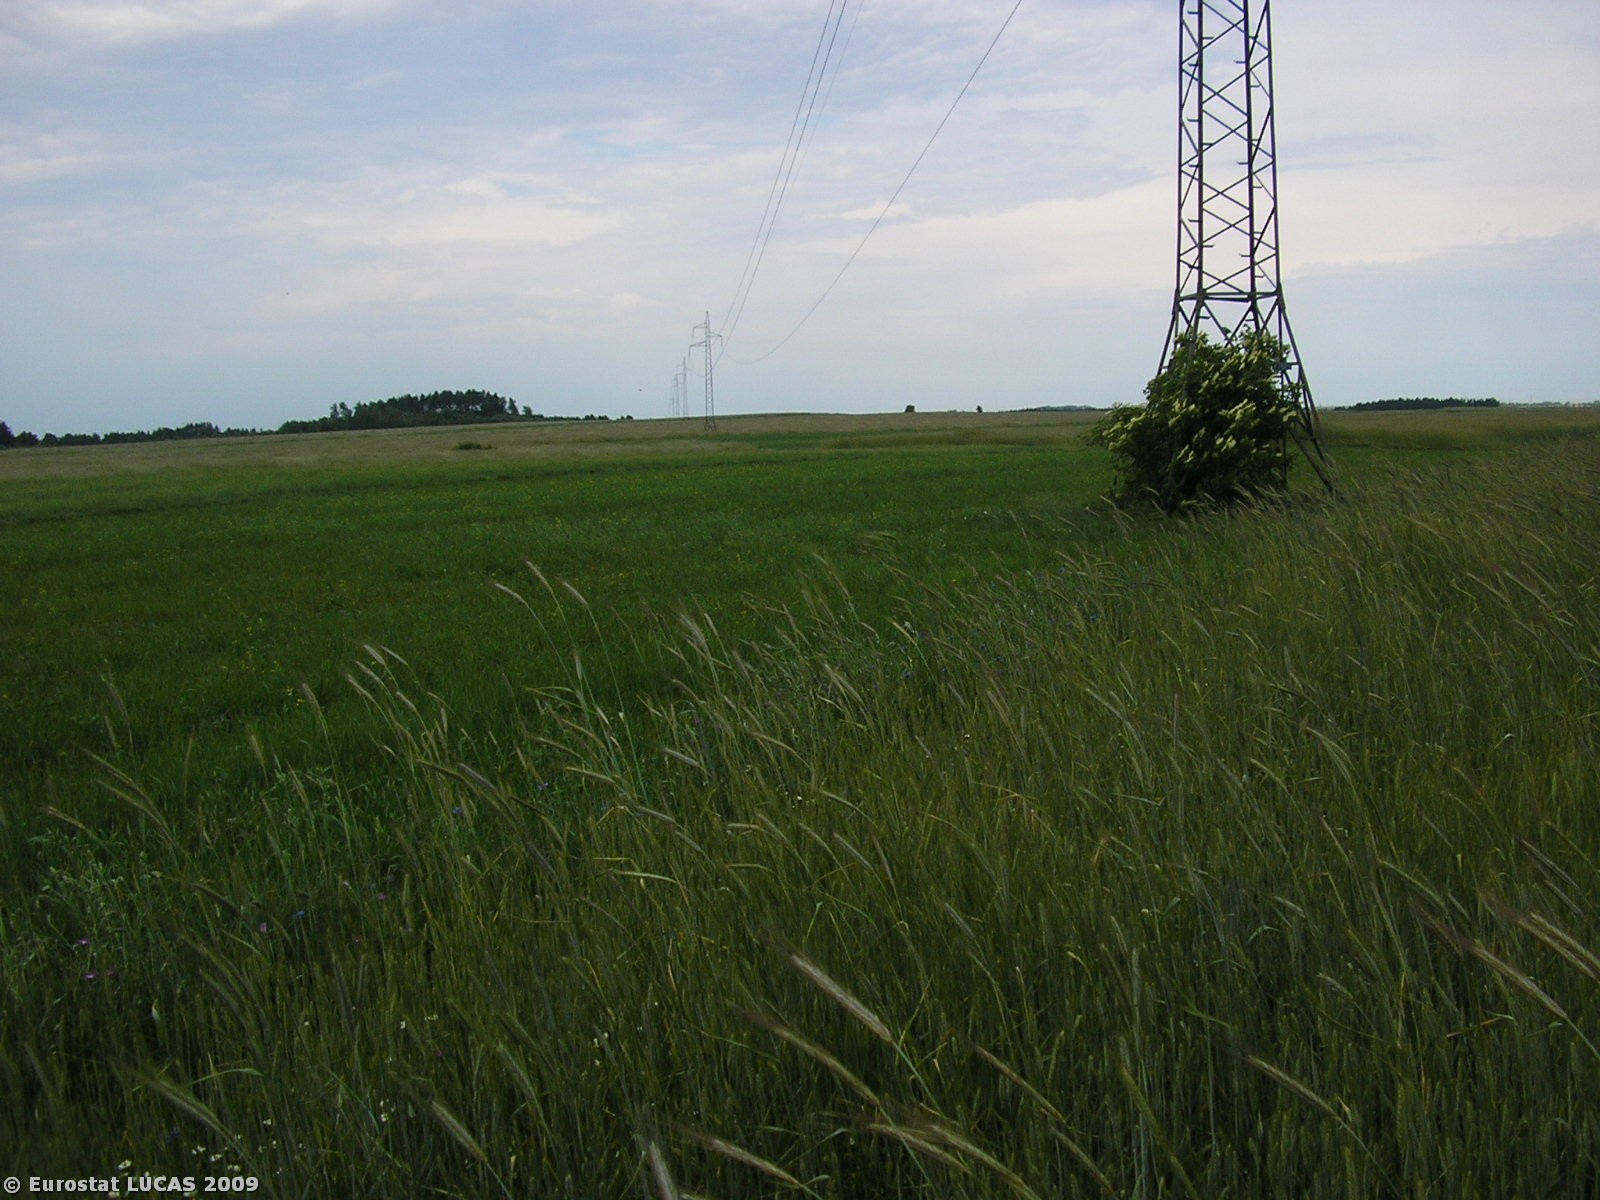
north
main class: Cropland
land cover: Triticale
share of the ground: 50 - 75 %
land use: Agriculture (excluding fallow land and kitchen gardens)
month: June
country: PL
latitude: 51.0849
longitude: 18.8878
